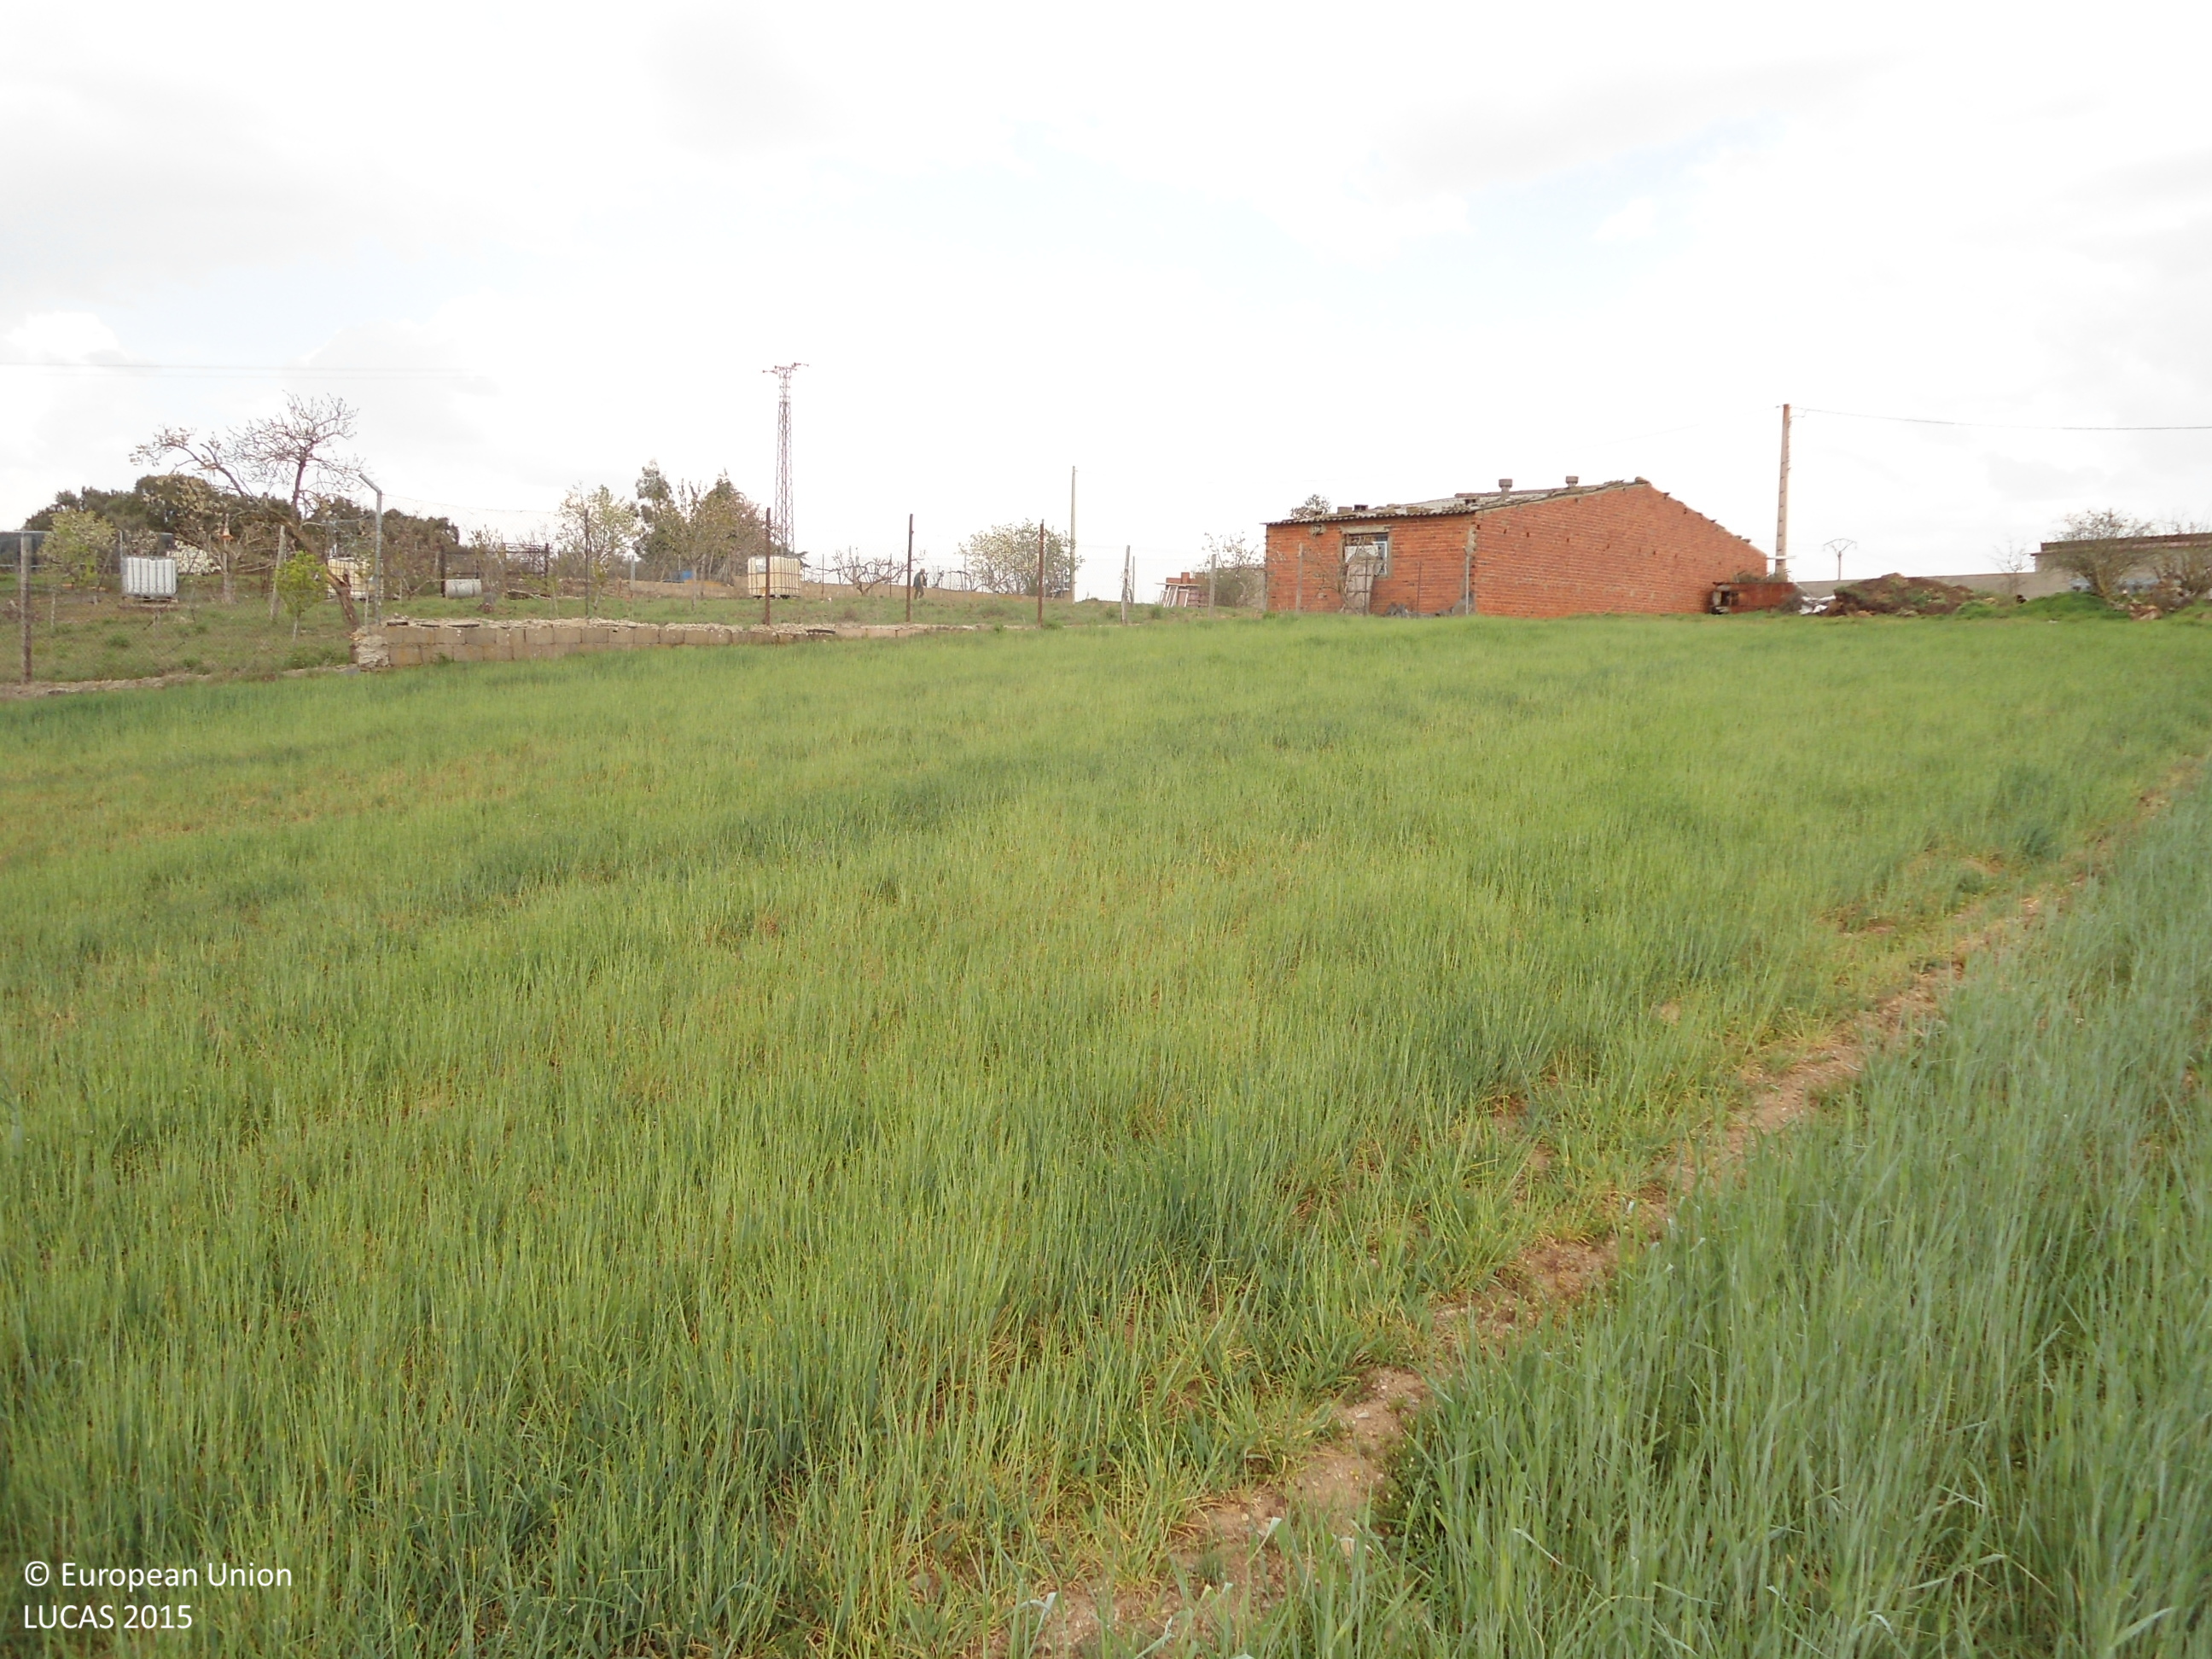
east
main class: Cropland
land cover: Rye
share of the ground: > 75 %
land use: Agriculture (excluding fallow land and kitchen gardens)
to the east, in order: Rye; Barley; Fences; Artificial constructions in urban areas; Fences; Grassland with sparse tree/shrub cover; Tracks; Grass margins; Artificial constructions in urban areas; Rye; Tracks; Grass margins; Dry stone walls; Rye; Dry stone walls; Broadleaved woodland; Dry stone walls; Grassland with sparse tree/shrub cover; Paved roads, cycling and walking lanes; Abandoned hedges; Dry stone walls; Grassland without tree/shrub cover
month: April
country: ES
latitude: 41.8244
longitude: -6.2715
